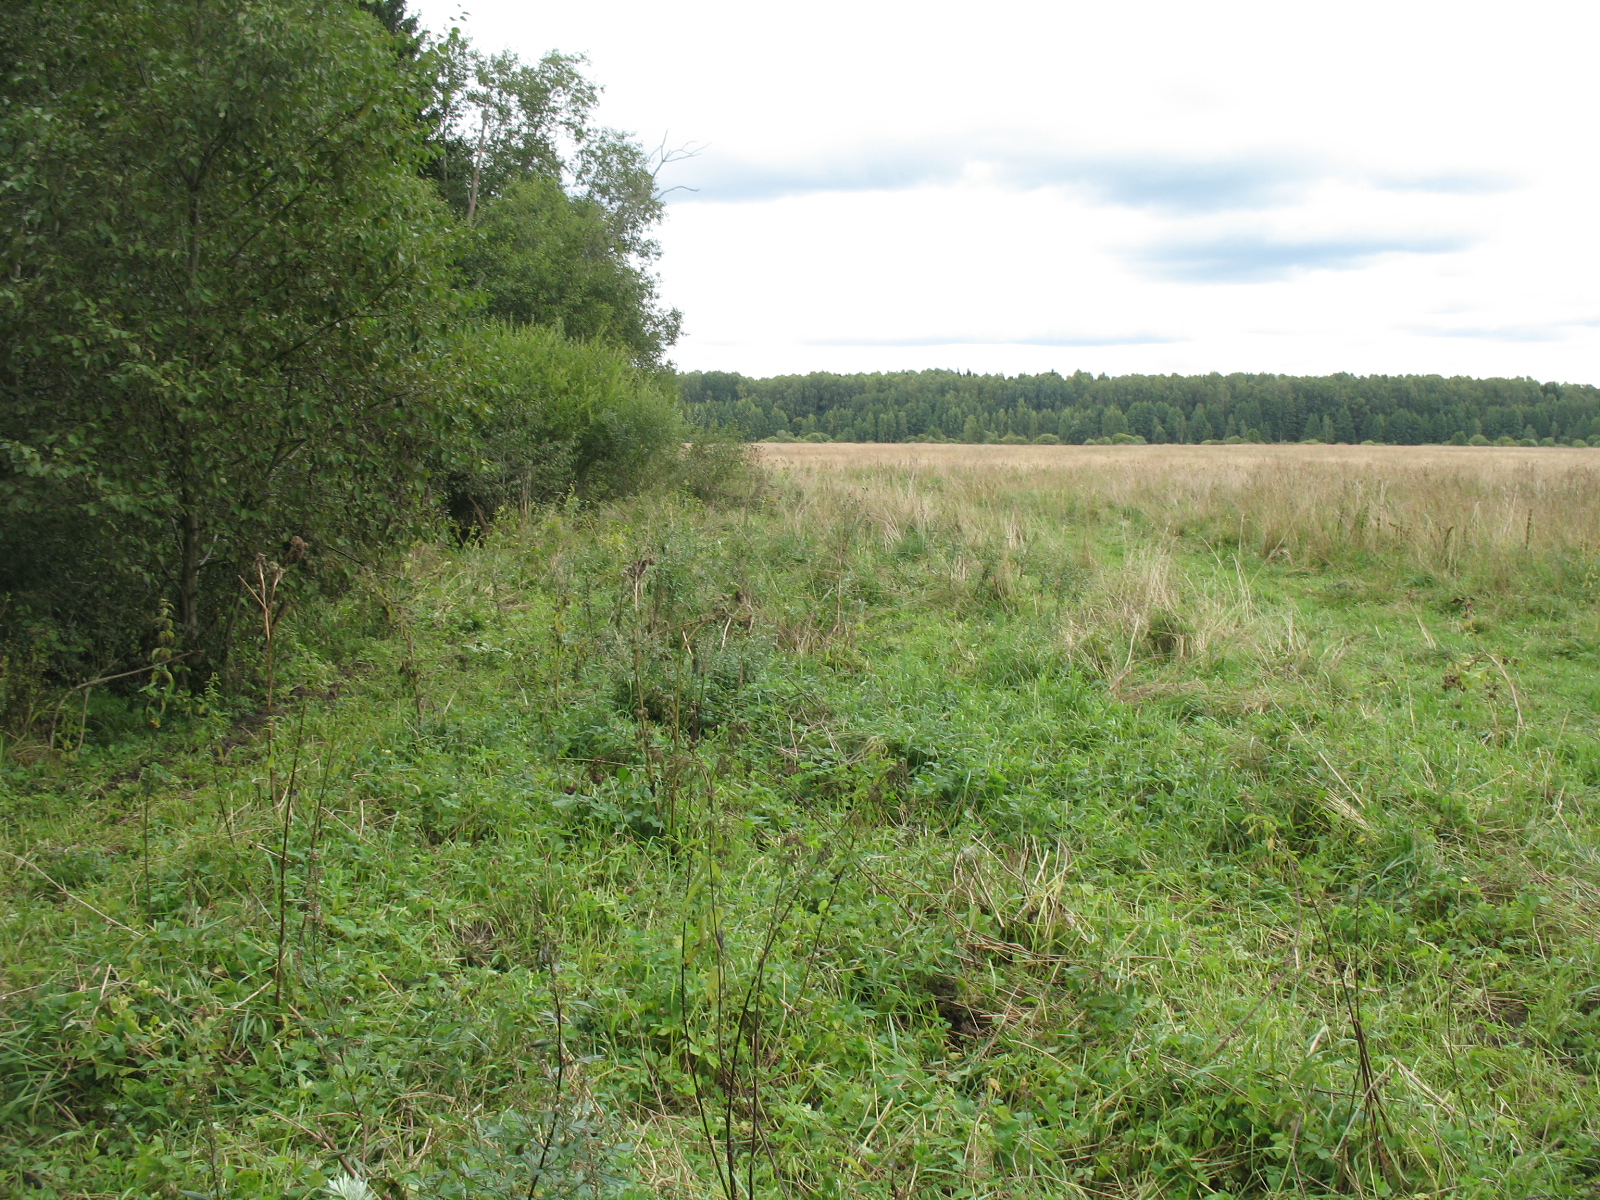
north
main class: Grassland
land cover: Grassland without tree/shrub cover
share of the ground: > 75 %
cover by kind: herbaceous plants 100 %
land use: Agriculture (excluding fallow land and kitchen gardens)
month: September
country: LV
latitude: 56.1182
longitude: 25.9443
